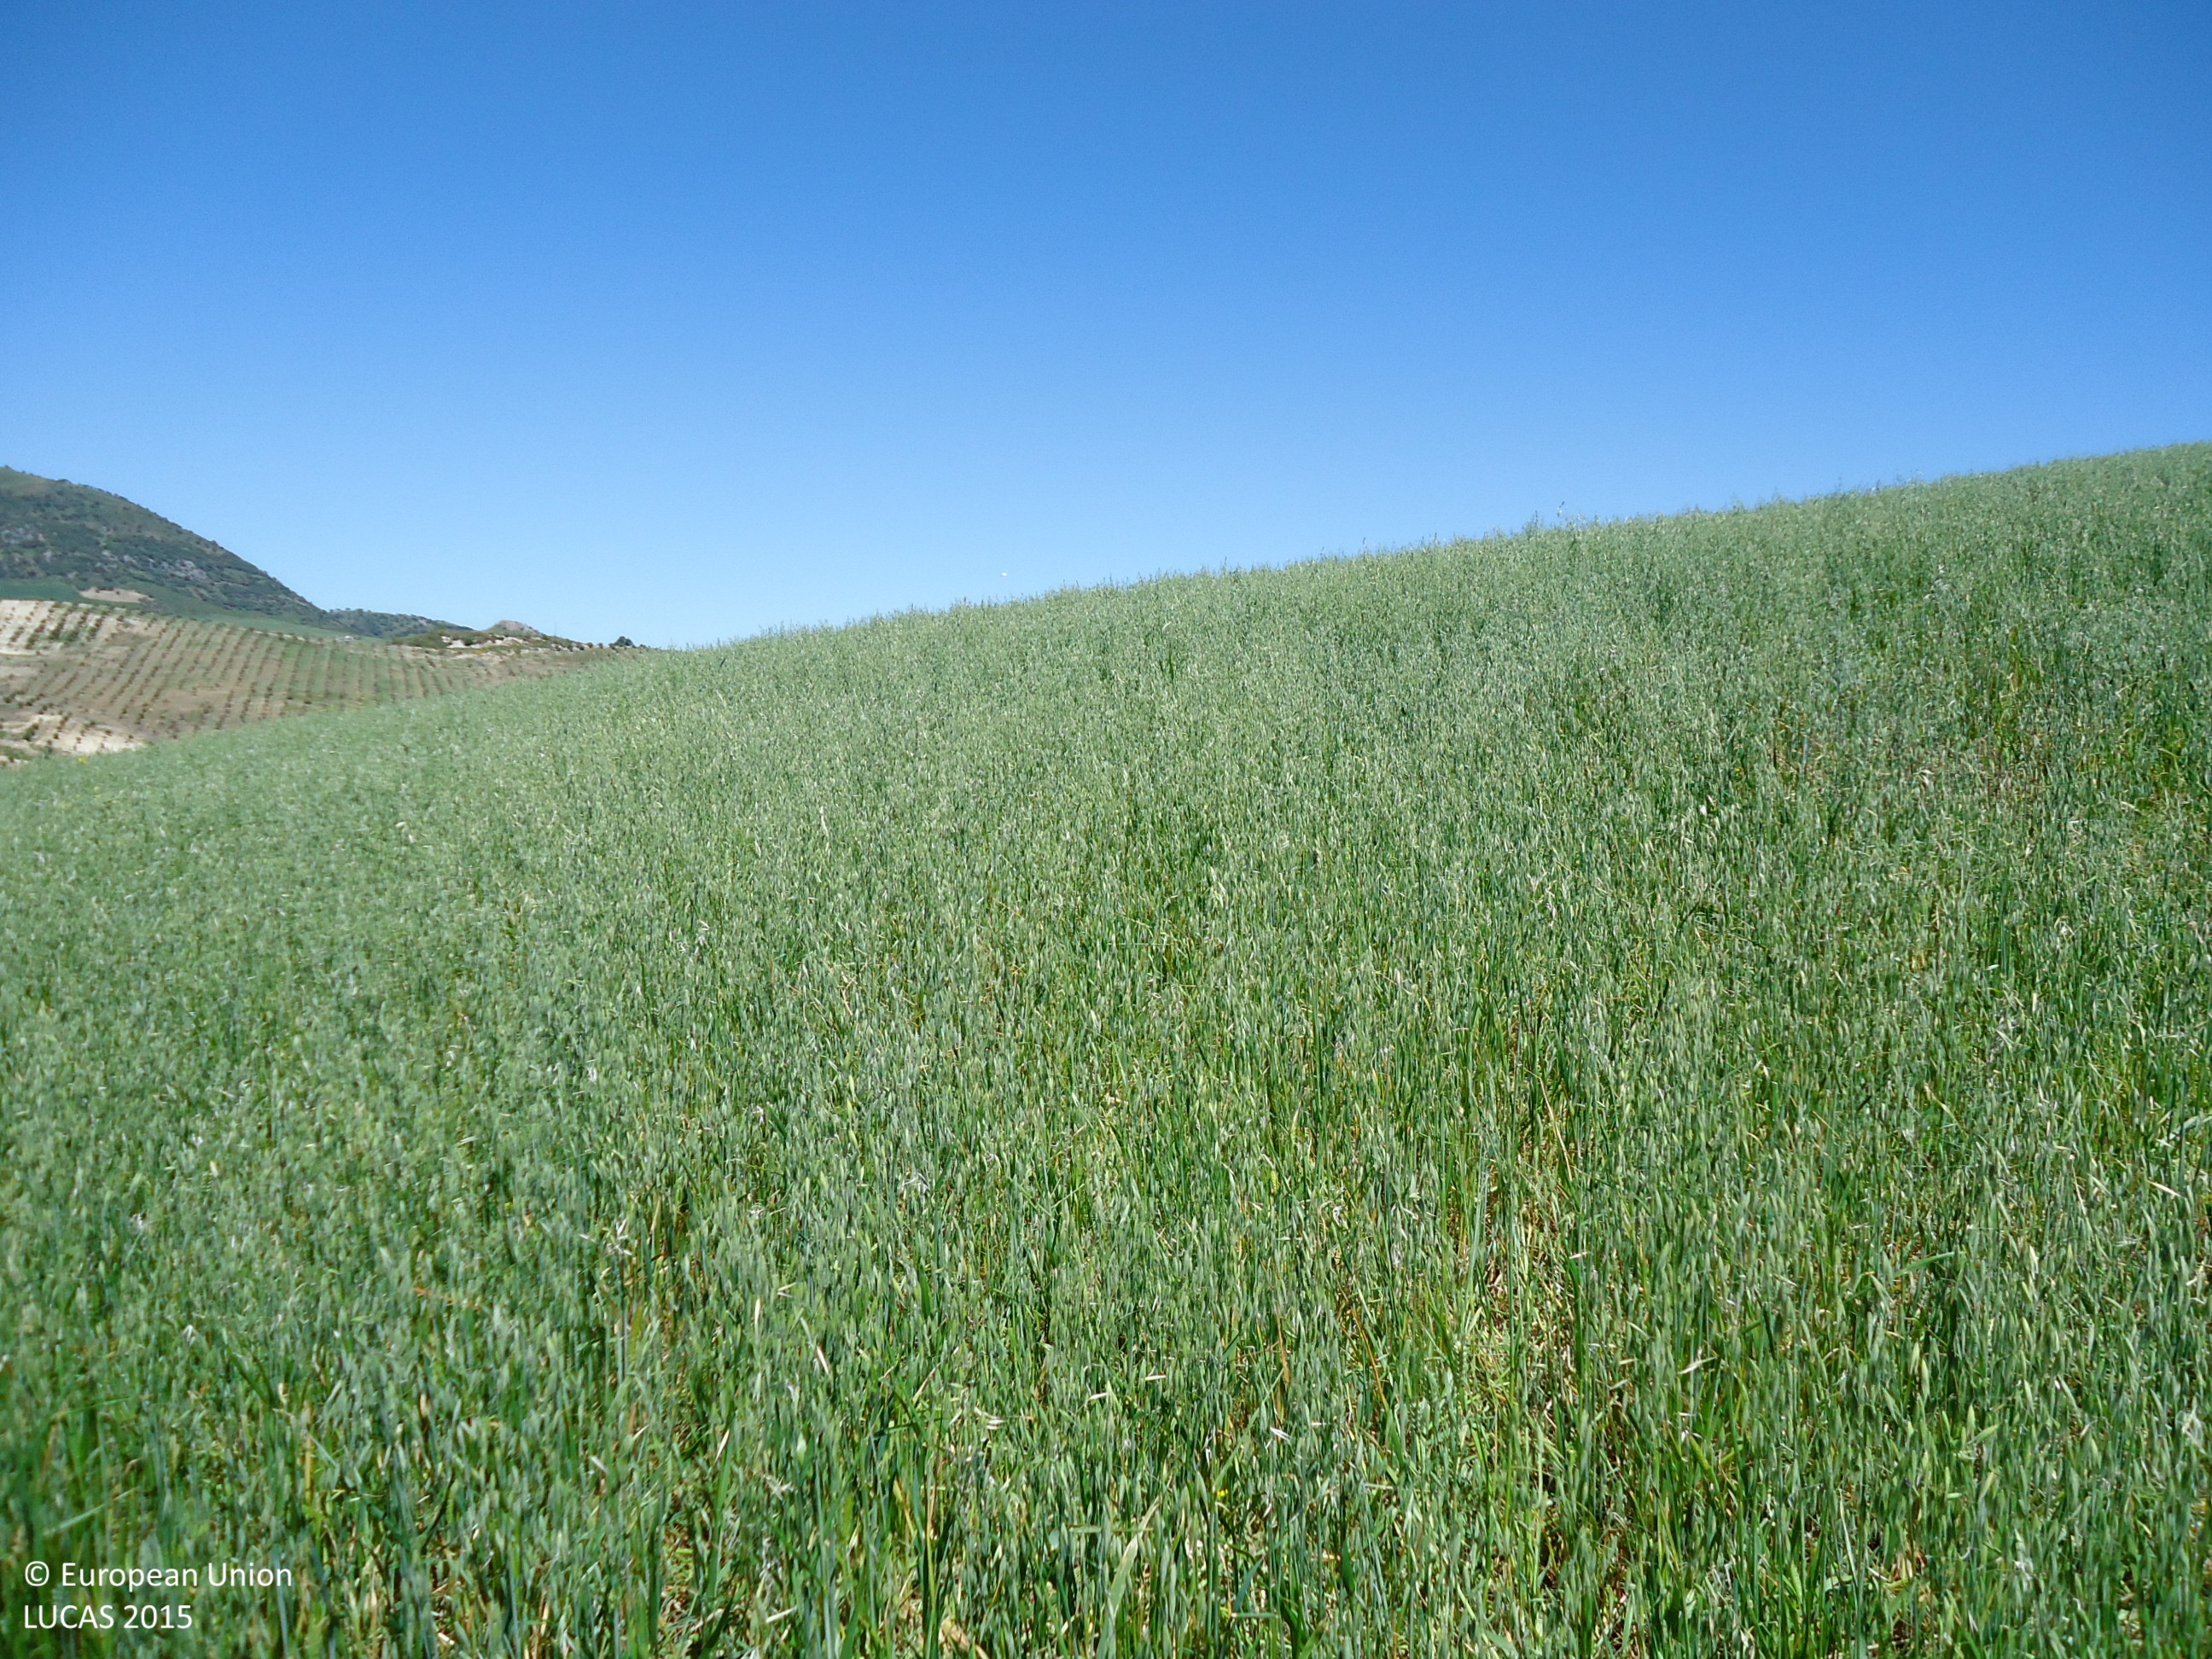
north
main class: Cropland
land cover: Oats
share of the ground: > 75 %
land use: Agriculture (excluding fallow land and kitchen gardens)
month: May
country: ES
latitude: 36.8212
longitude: -5.2599
